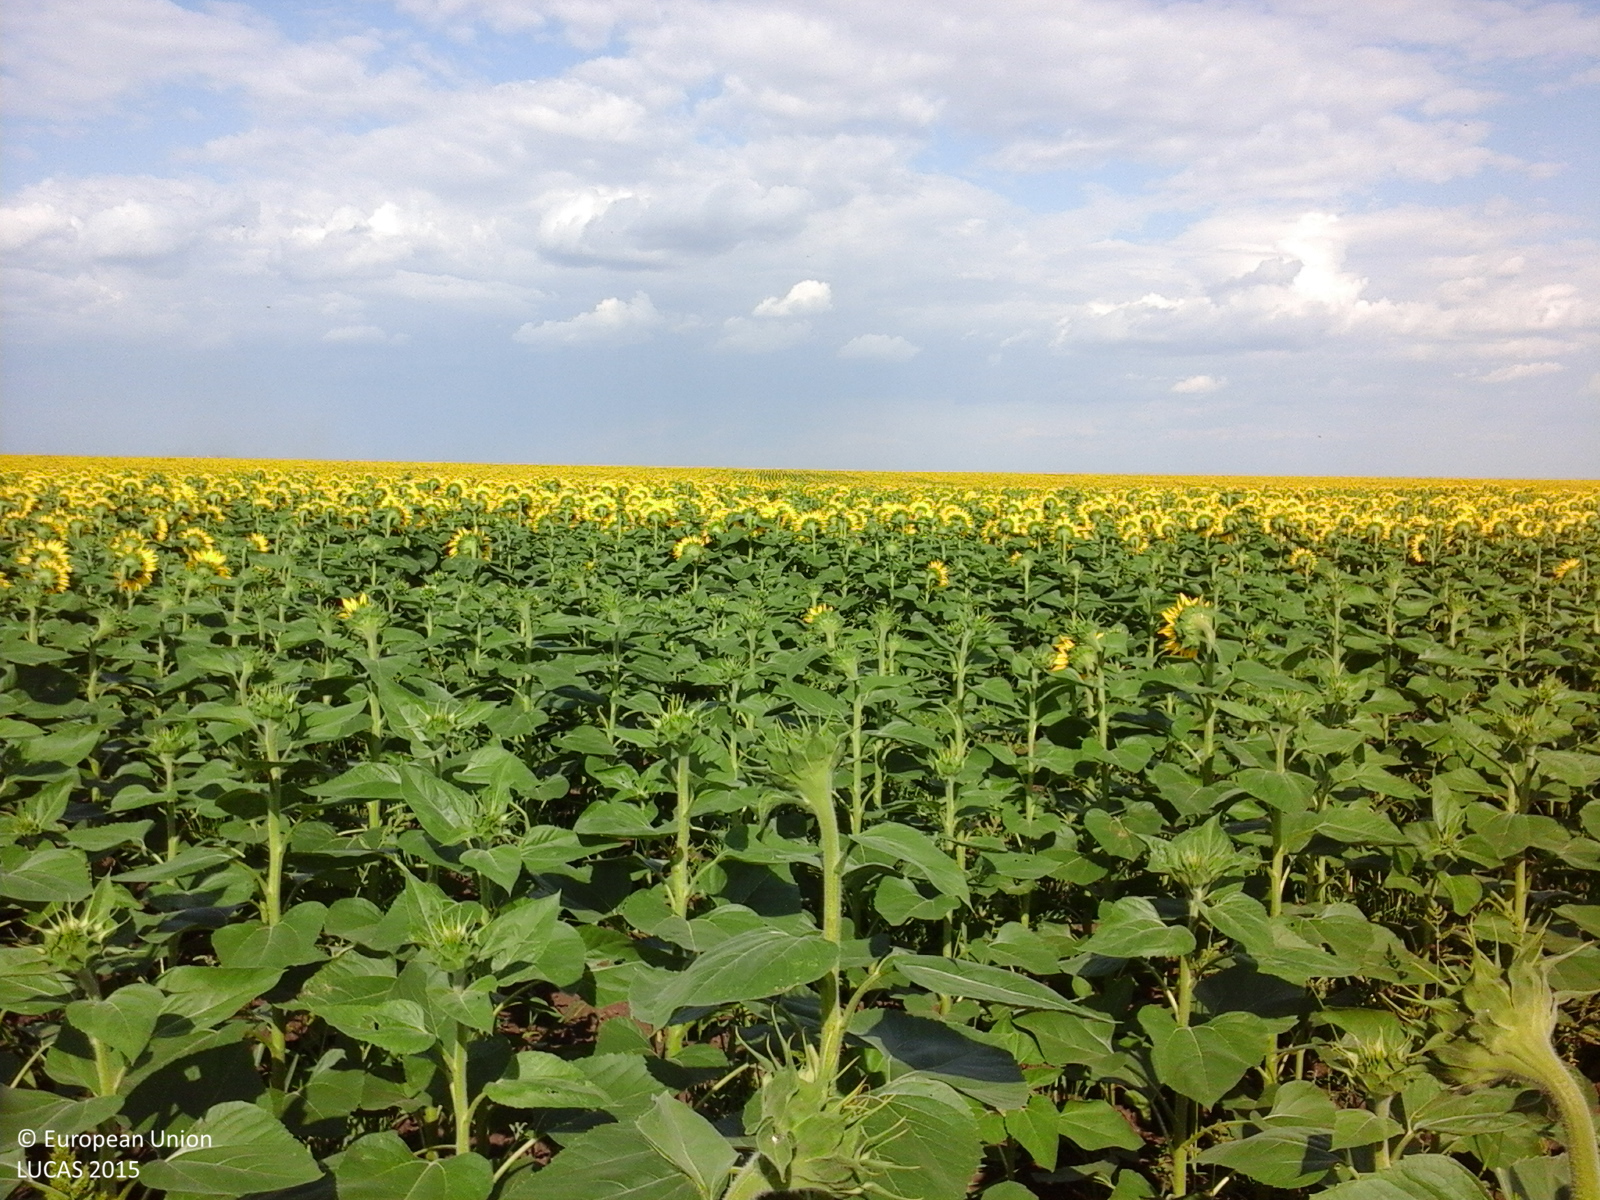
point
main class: Cropland
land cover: Sunflower
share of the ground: > 75 %
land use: Agriculture (excluding fallow land and kitchen gardens)
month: July
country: RO
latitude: 44.0777
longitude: 24.8717
